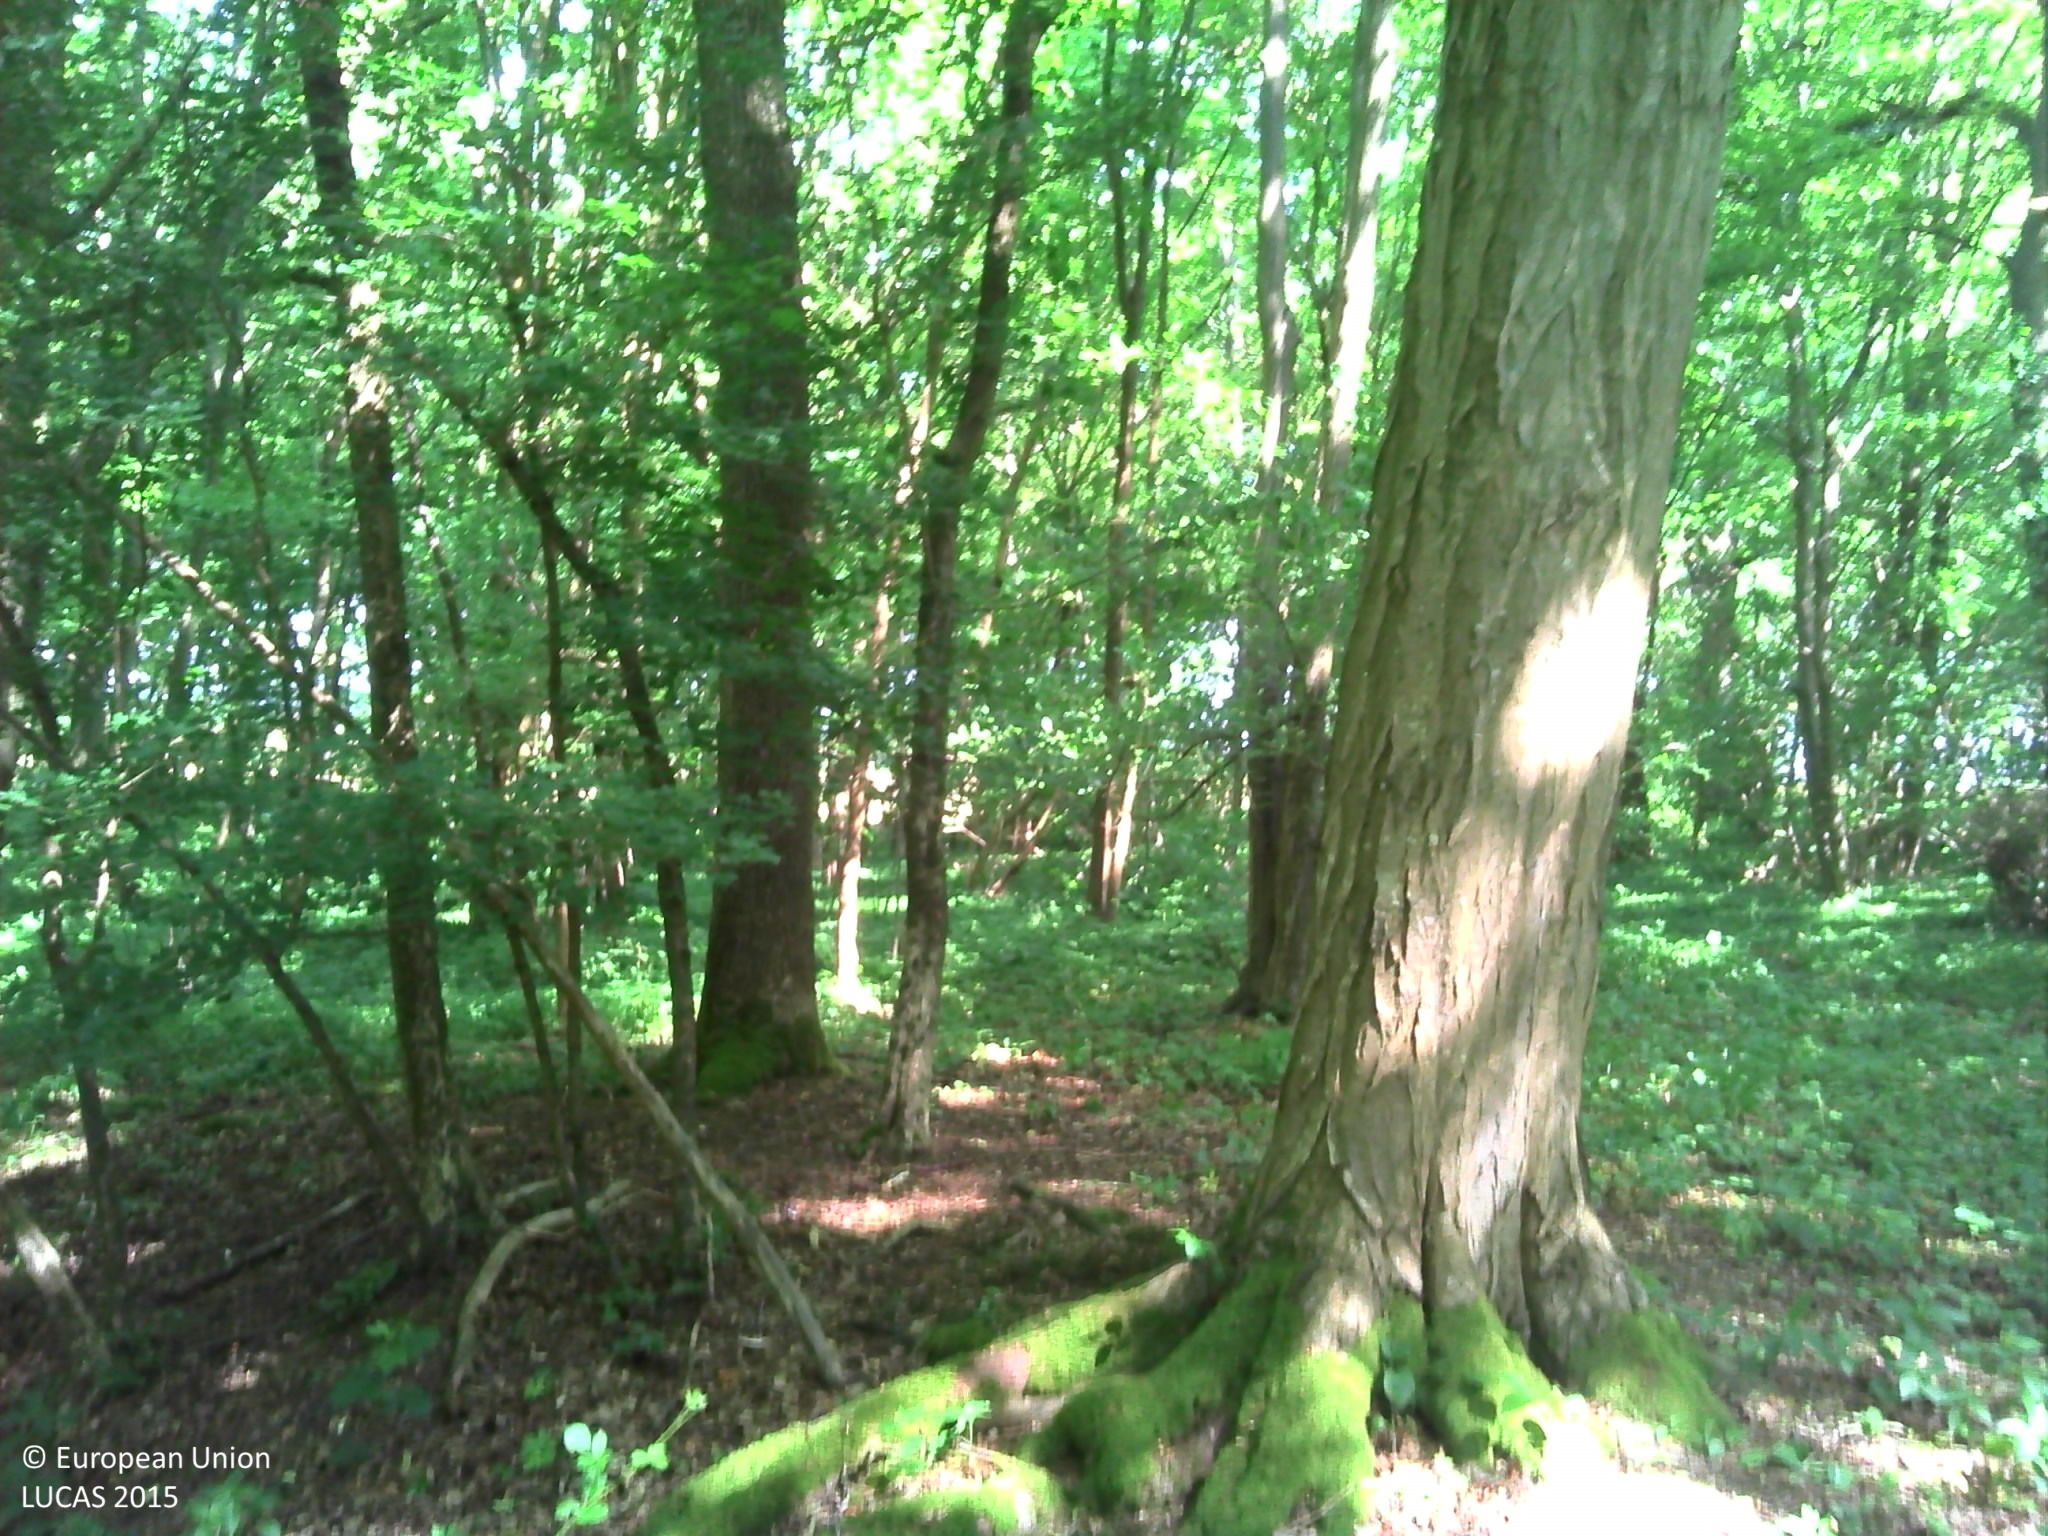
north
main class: Woodland
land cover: Broadleaved woodland
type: mesophytic deciduous forest
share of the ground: > 75 %
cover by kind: broadleaved forest trees 55 %, herbaceous plants 40 %, shrubs 5 %
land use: Forestry
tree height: > 5 m
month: June
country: FR
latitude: 49.5423
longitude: 2.5392
